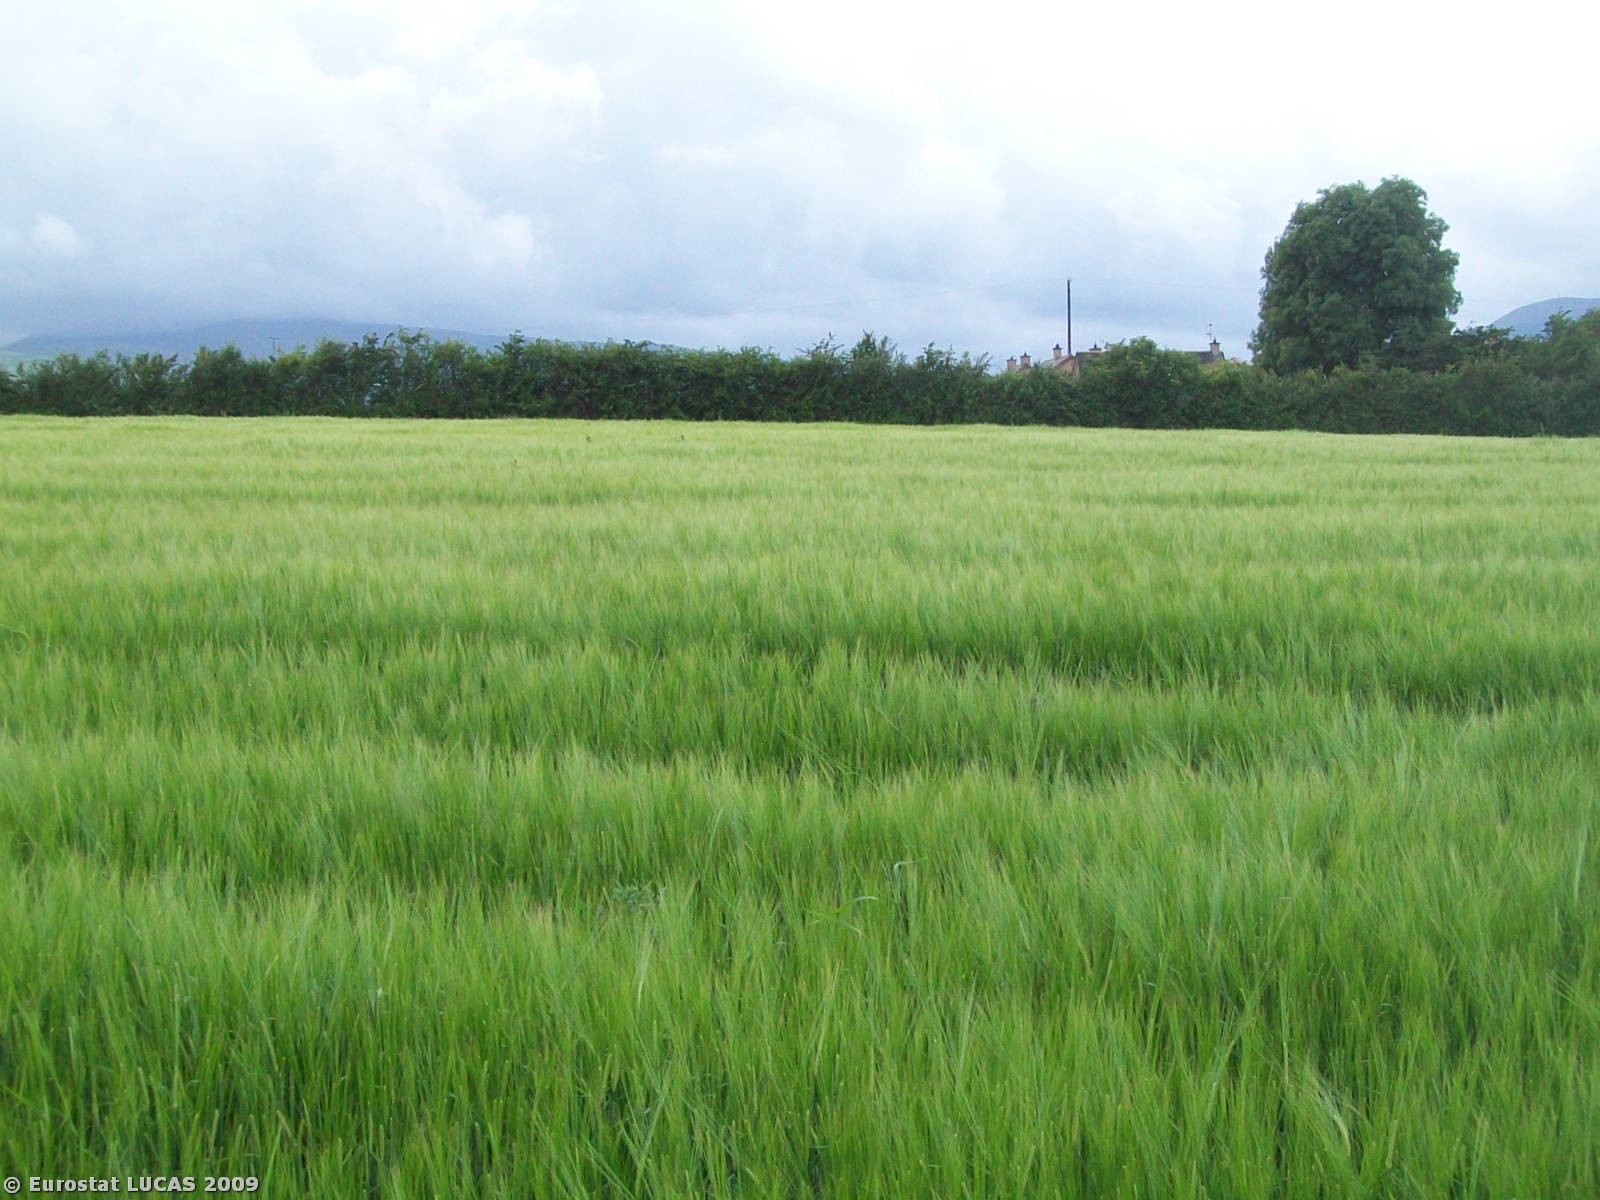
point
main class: Cropland
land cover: Barley
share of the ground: > 75 %
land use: Agriculture (excluding fallow land and kitchen gardens)
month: July
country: GB
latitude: 54.7931
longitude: -6.7893
